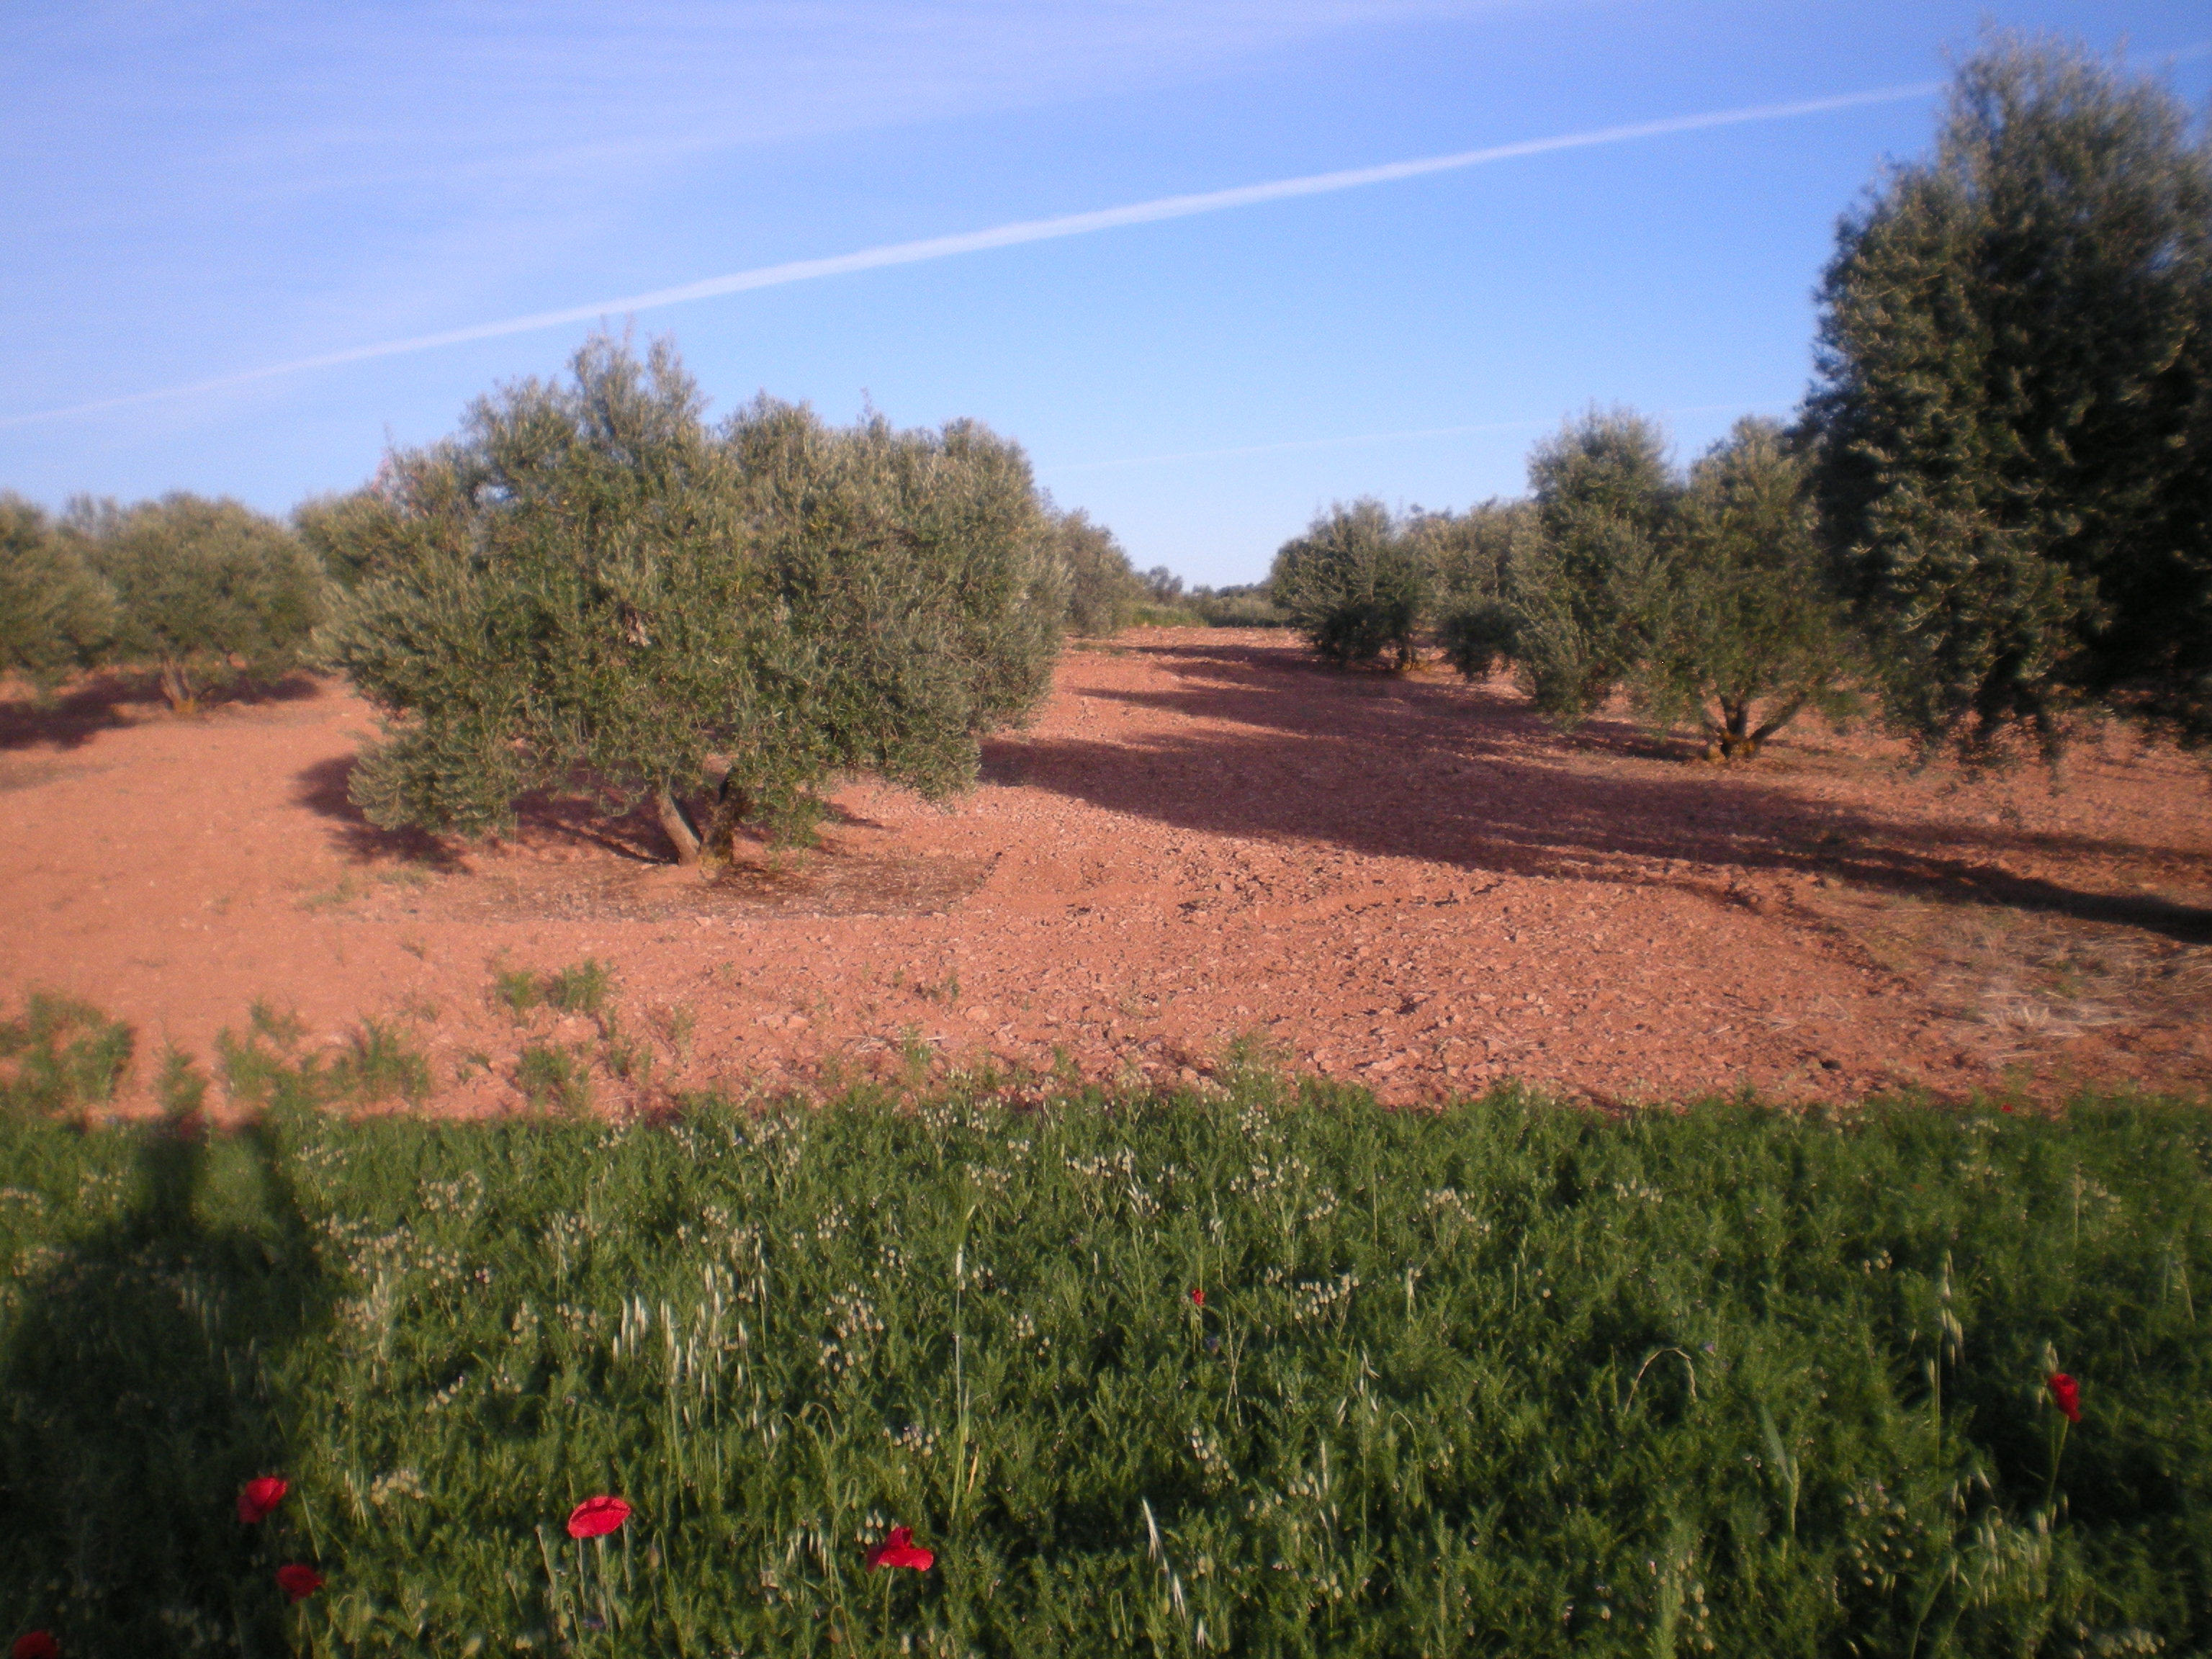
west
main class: Cropland
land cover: Dry pulses
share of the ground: > 75 %
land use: Agriculture (excluding fallow land and kitchen gardens)
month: May
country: ES
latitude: 38.9352
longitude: -3.1740
